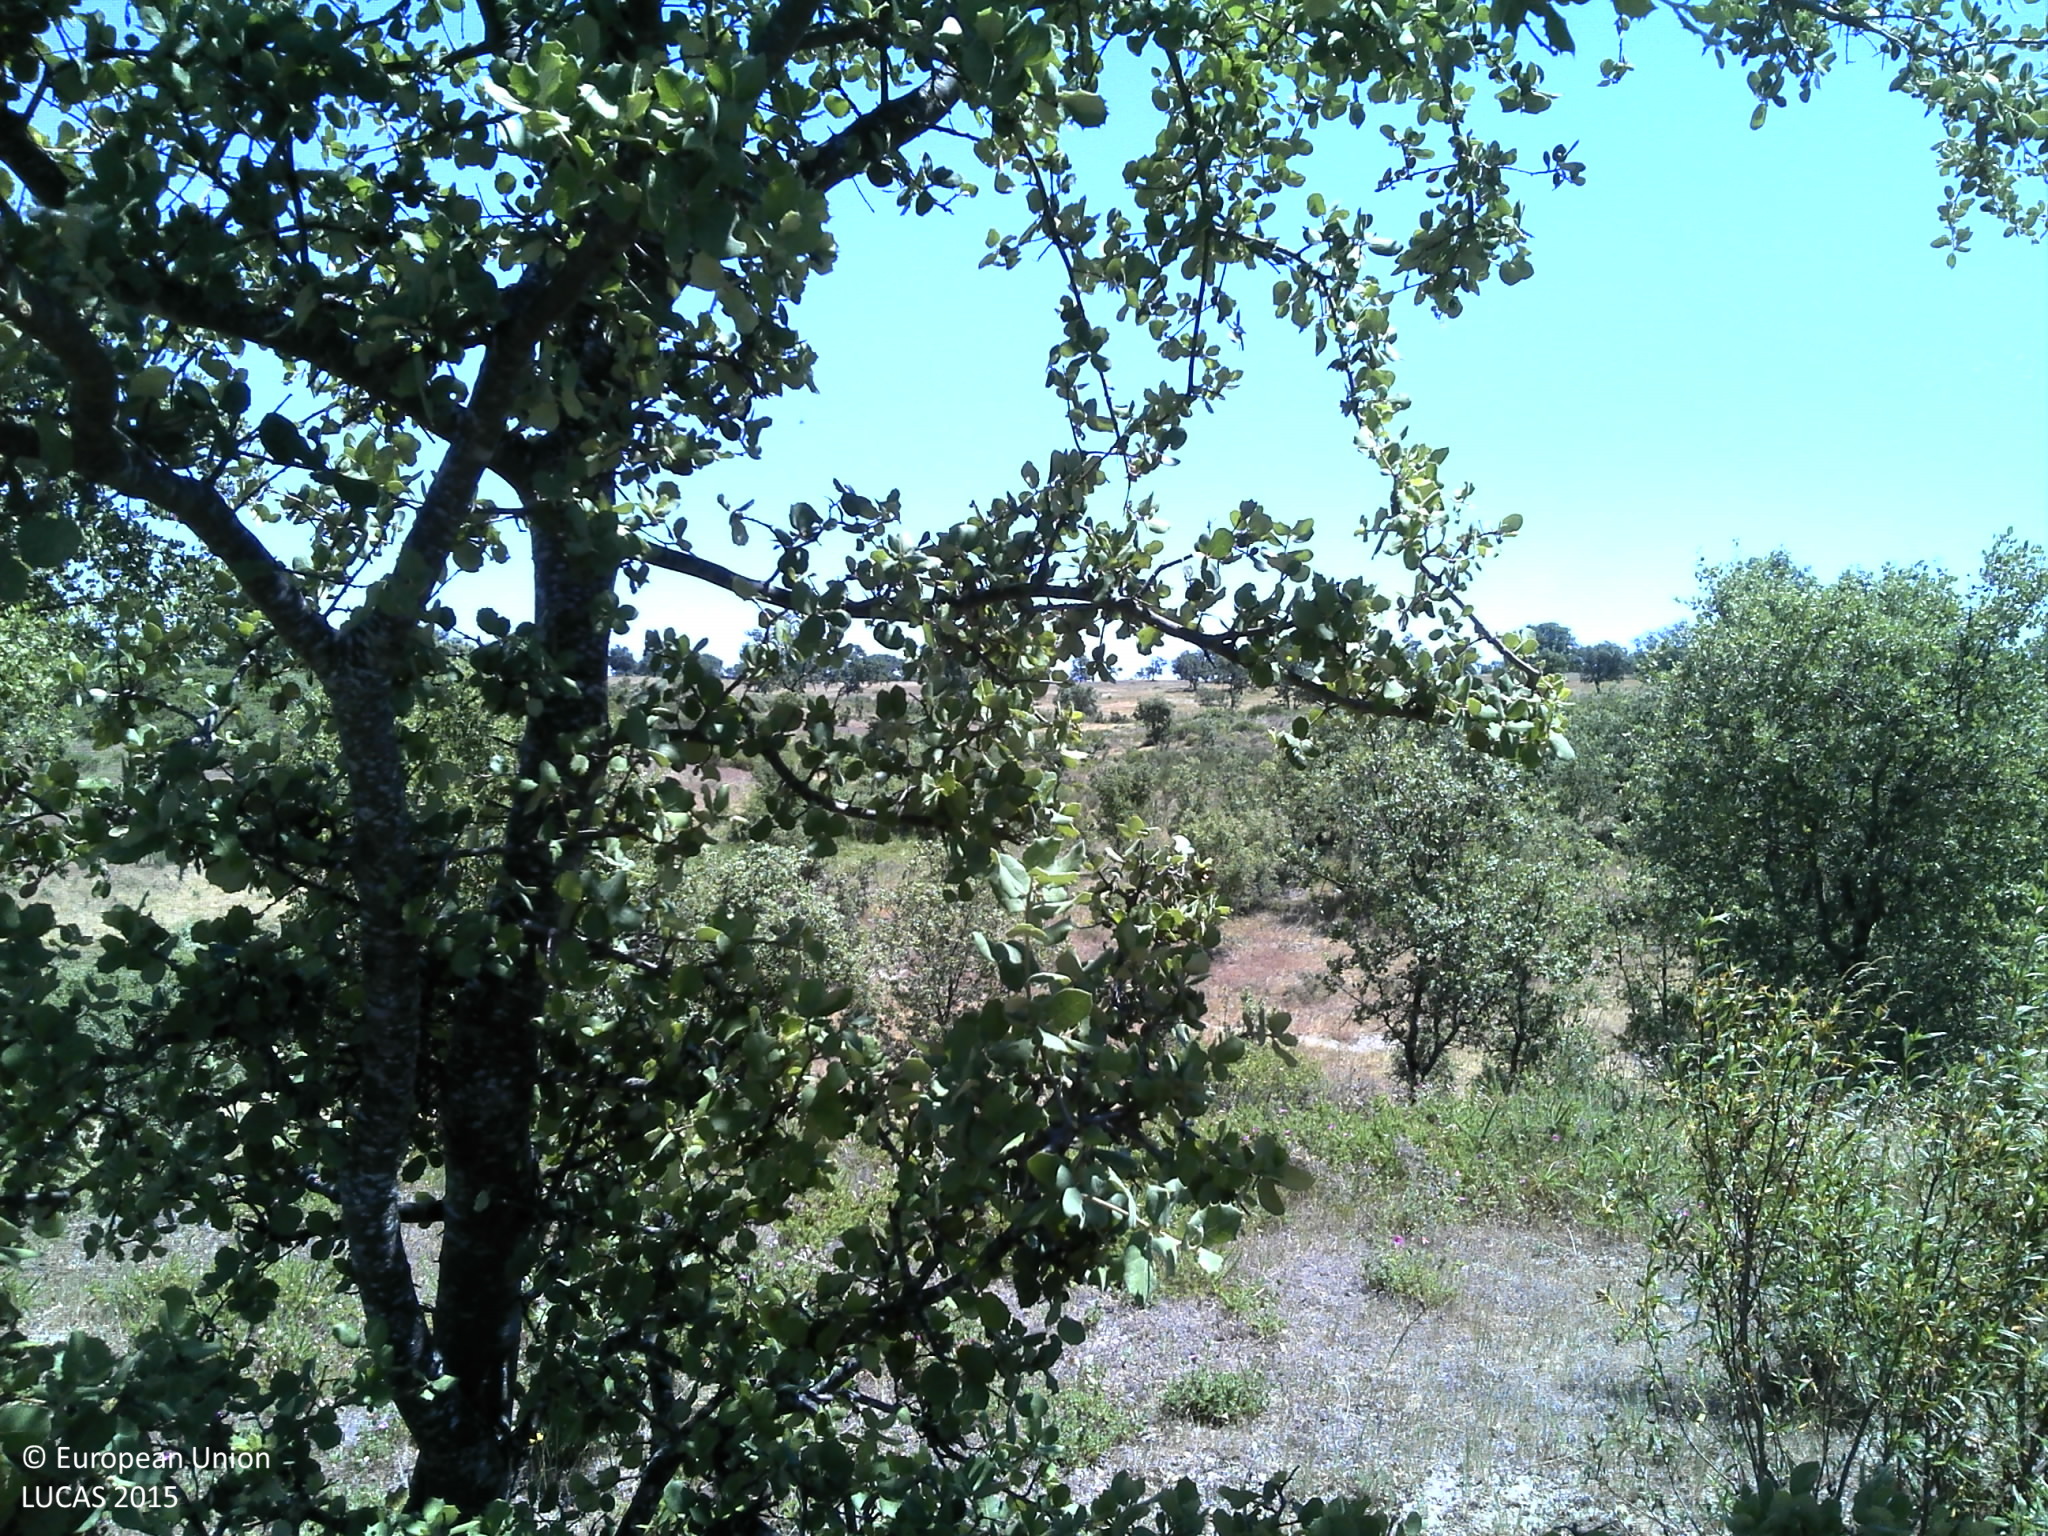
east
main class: Woodland
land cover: Broadleaved woodland
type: thermophilous deciduous forest
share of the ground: 25 - 50 %
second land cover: Grassland without tree/shrub cover
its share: 50 - 75 %
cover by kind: herbaceous plants 40 %, broadleaved forest trees 30 %, unconsolidated bare surface 25 %, shrubs 5 %
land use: Forestry
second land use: Agriculture (excluding fallow land and kitchen gardens)
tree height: > 5 m
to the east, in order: Broadleaved woodland; Grassland without tree/shrub cover; Broadleaved woodland; Grassland with sparse tree/shrub cover; Rivers and streams; Shrubland with sparse tree cover; Grassland with sparse tree/shrub cover; Broadleaved woodland
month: May
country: PT
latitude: 39.4772
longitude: -7.6863
